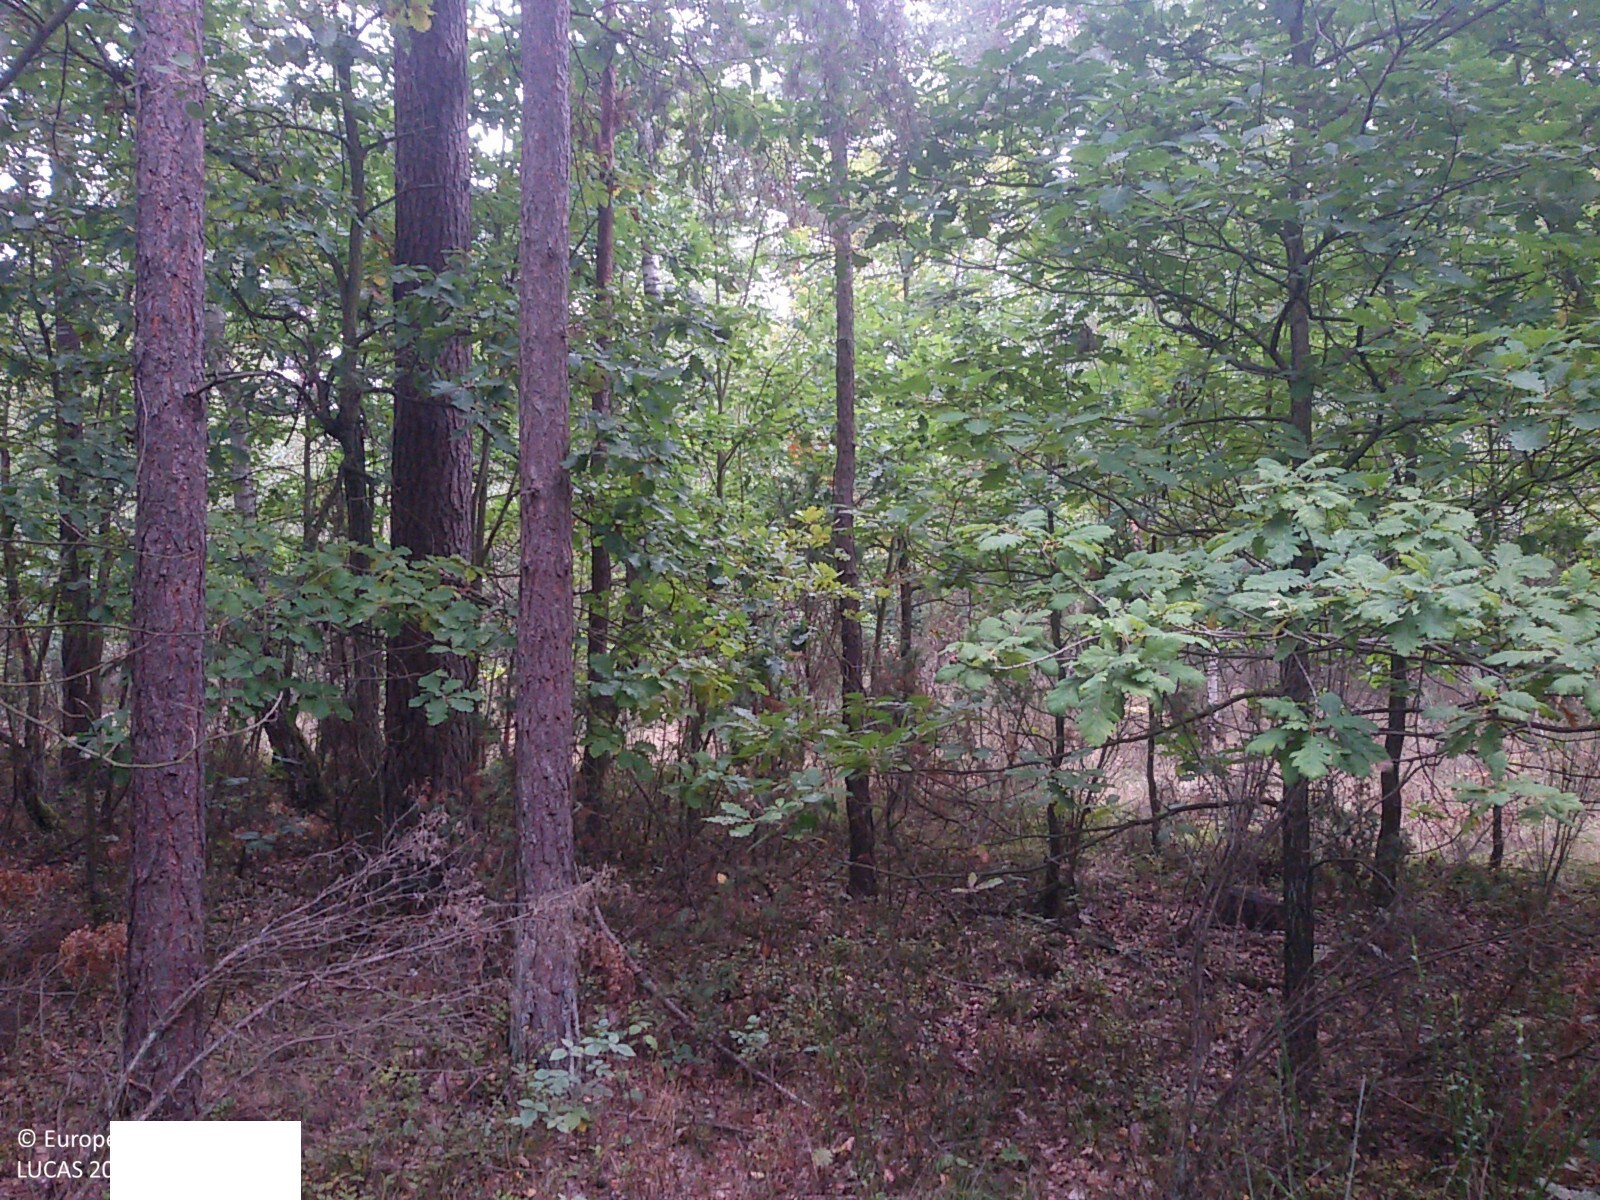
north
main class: Woodland
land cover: Pine dominated mixed woodland
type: hemiboreal forest and nemoral coniferous forest and mixed broadleaved-coniferous forest
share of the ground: > 75 %
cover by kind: coniferous forest trees 70 %, broadleaved forest trees 25 %, herbaceous plants 5 %
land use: Forestry
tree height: > 5 m
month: September
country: PL
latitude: 51.1627
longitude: 18.8163
